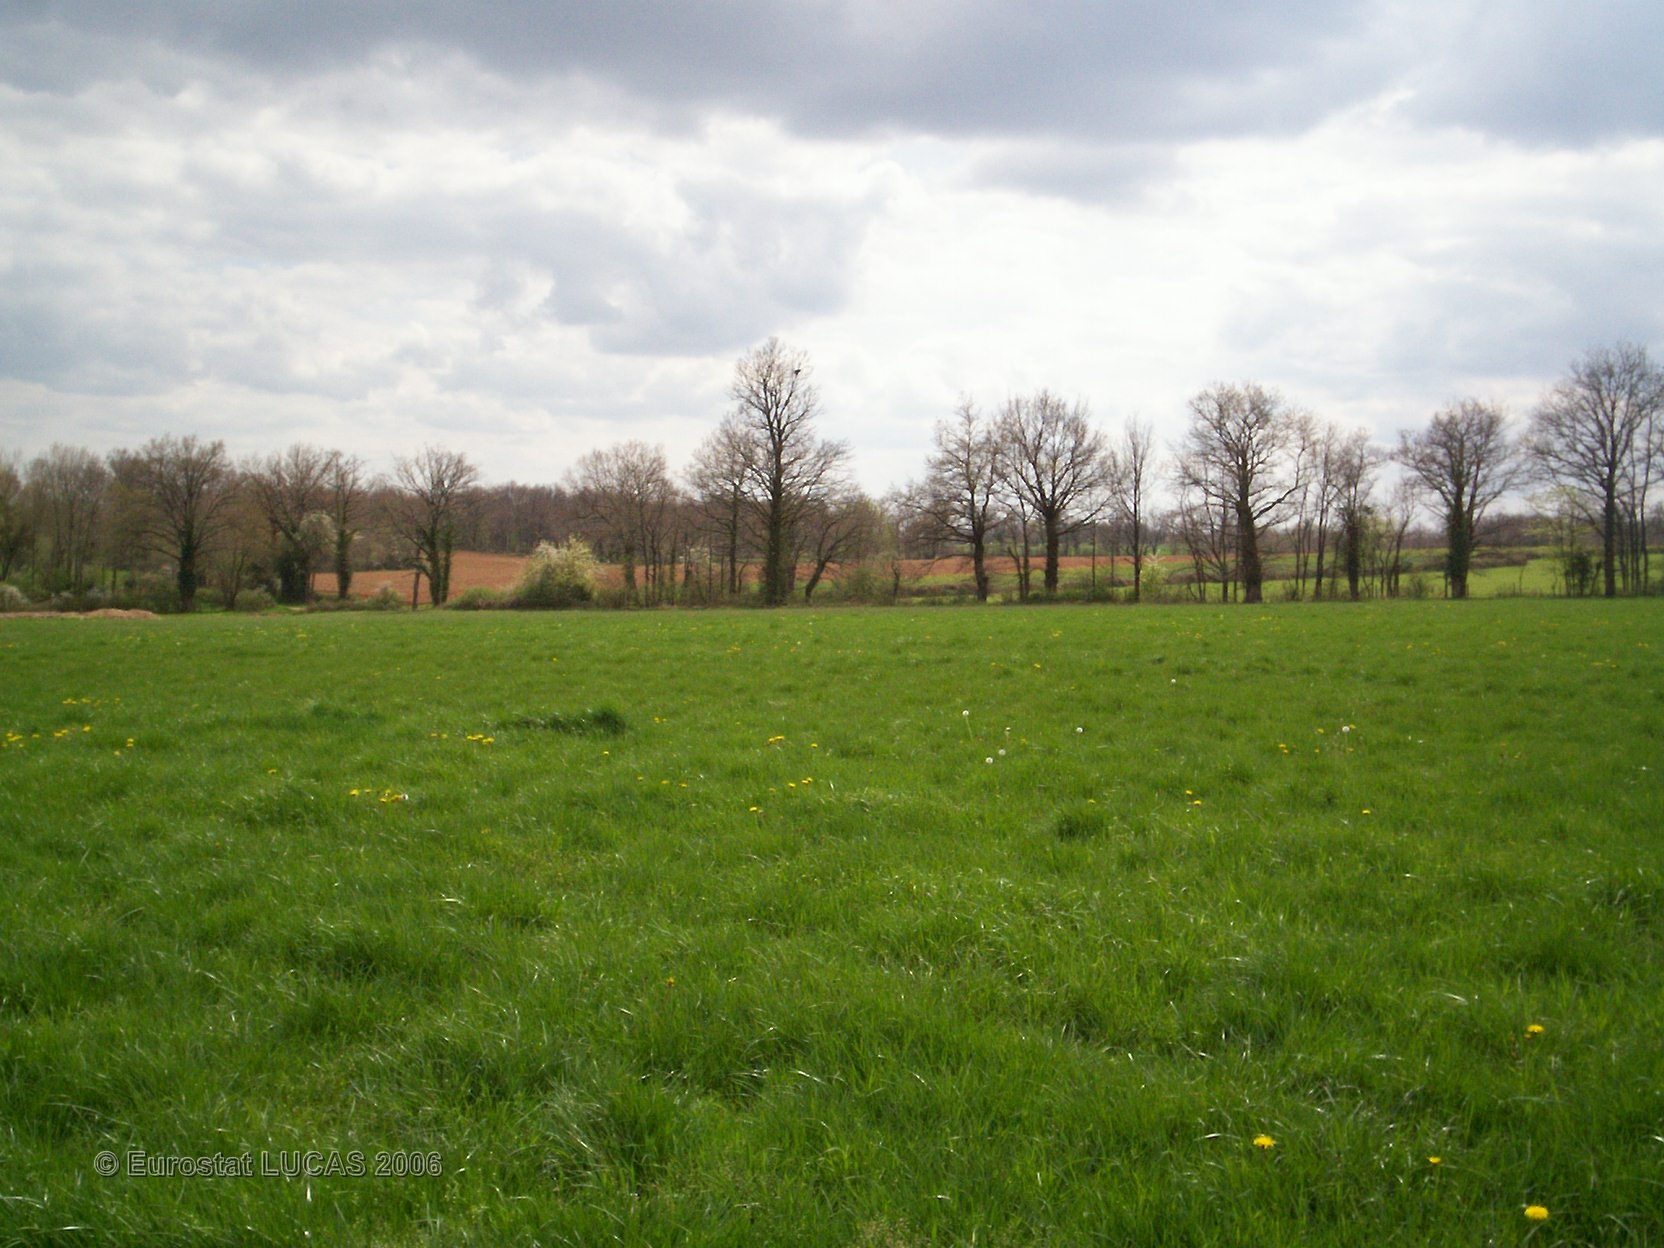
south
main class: Grassland
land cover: Grassland without tree/shrub cover
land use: Agriculture (excluding fallow land and kitchen gardens)
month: April
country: FR
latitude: 46.0709
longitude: 0.4815
